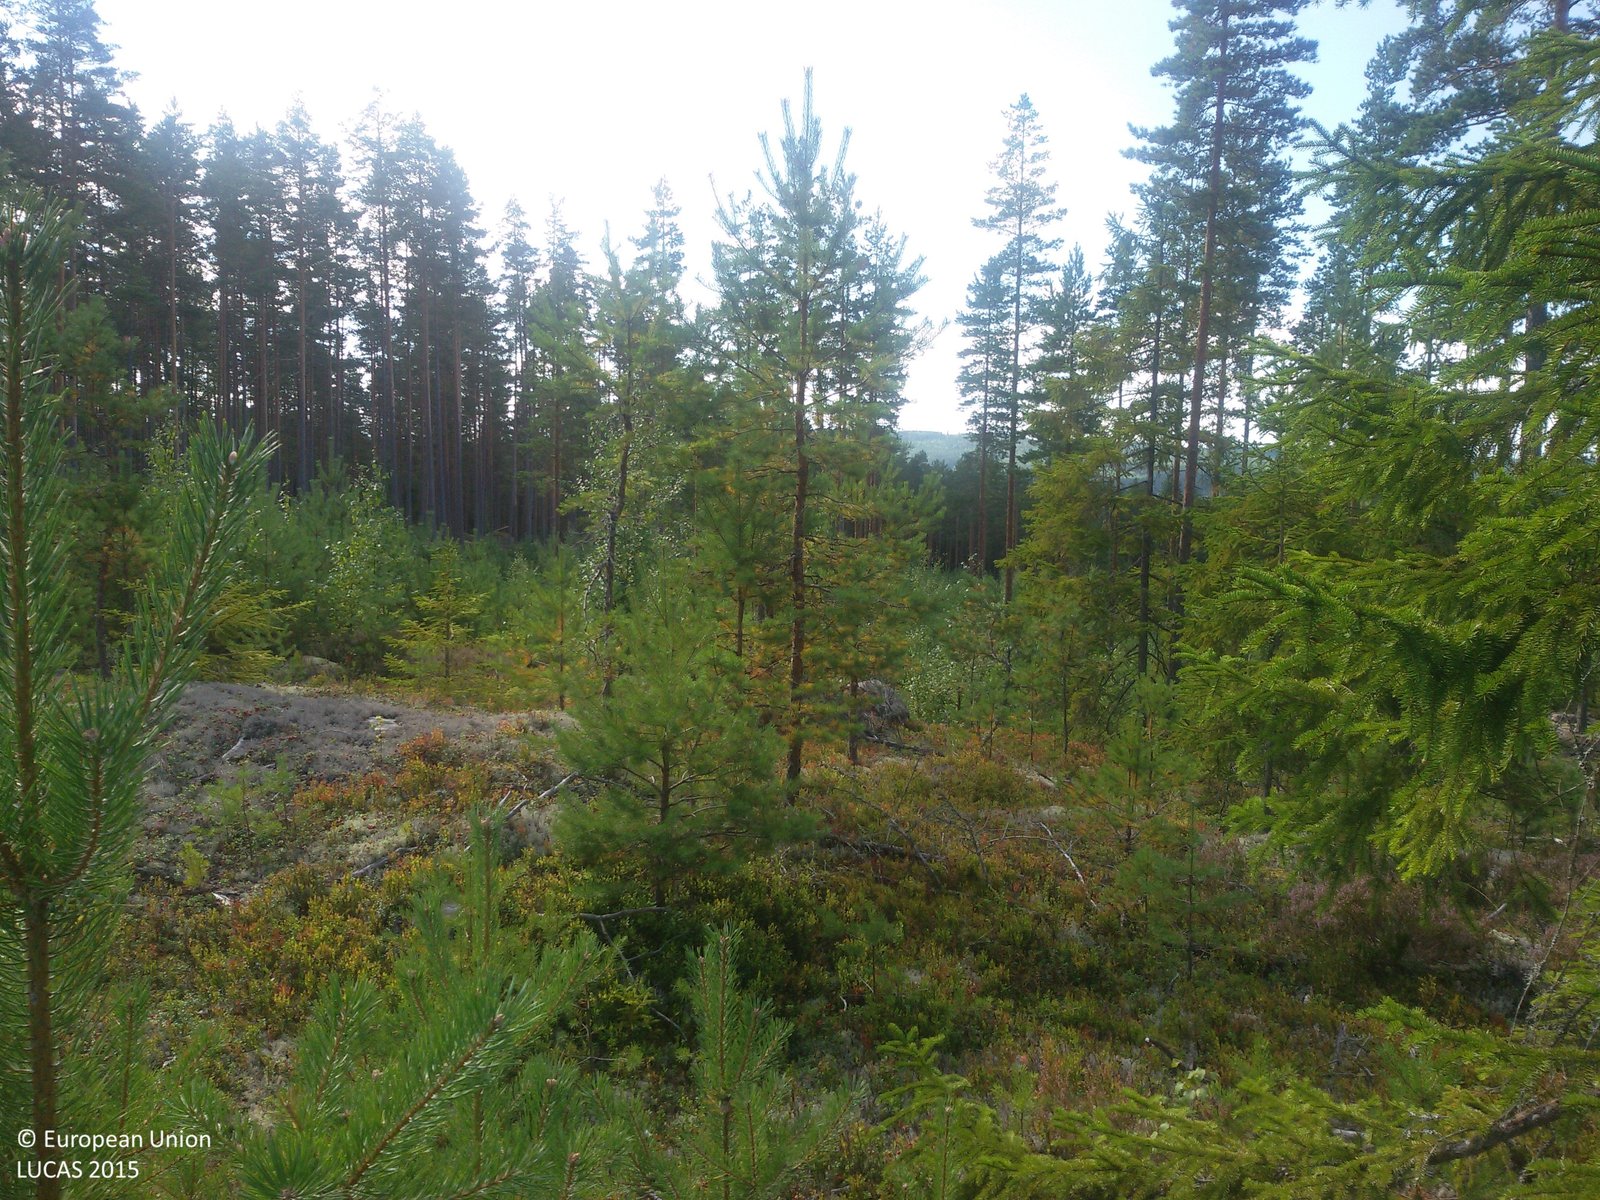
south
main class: Woodland
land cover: Pine dominated mixed woodland
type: boreal forest
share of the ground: 50 - 75 %
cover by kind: herbaceous plants 35 %, coniferous forest trees 30 %, broadleaved forest trees 20 %, lichens and mosses 15 %
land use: Forestry
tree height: < 5 m
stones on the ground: > 50 %
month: August
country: SE
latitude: 60.6952
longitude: 15.7565
